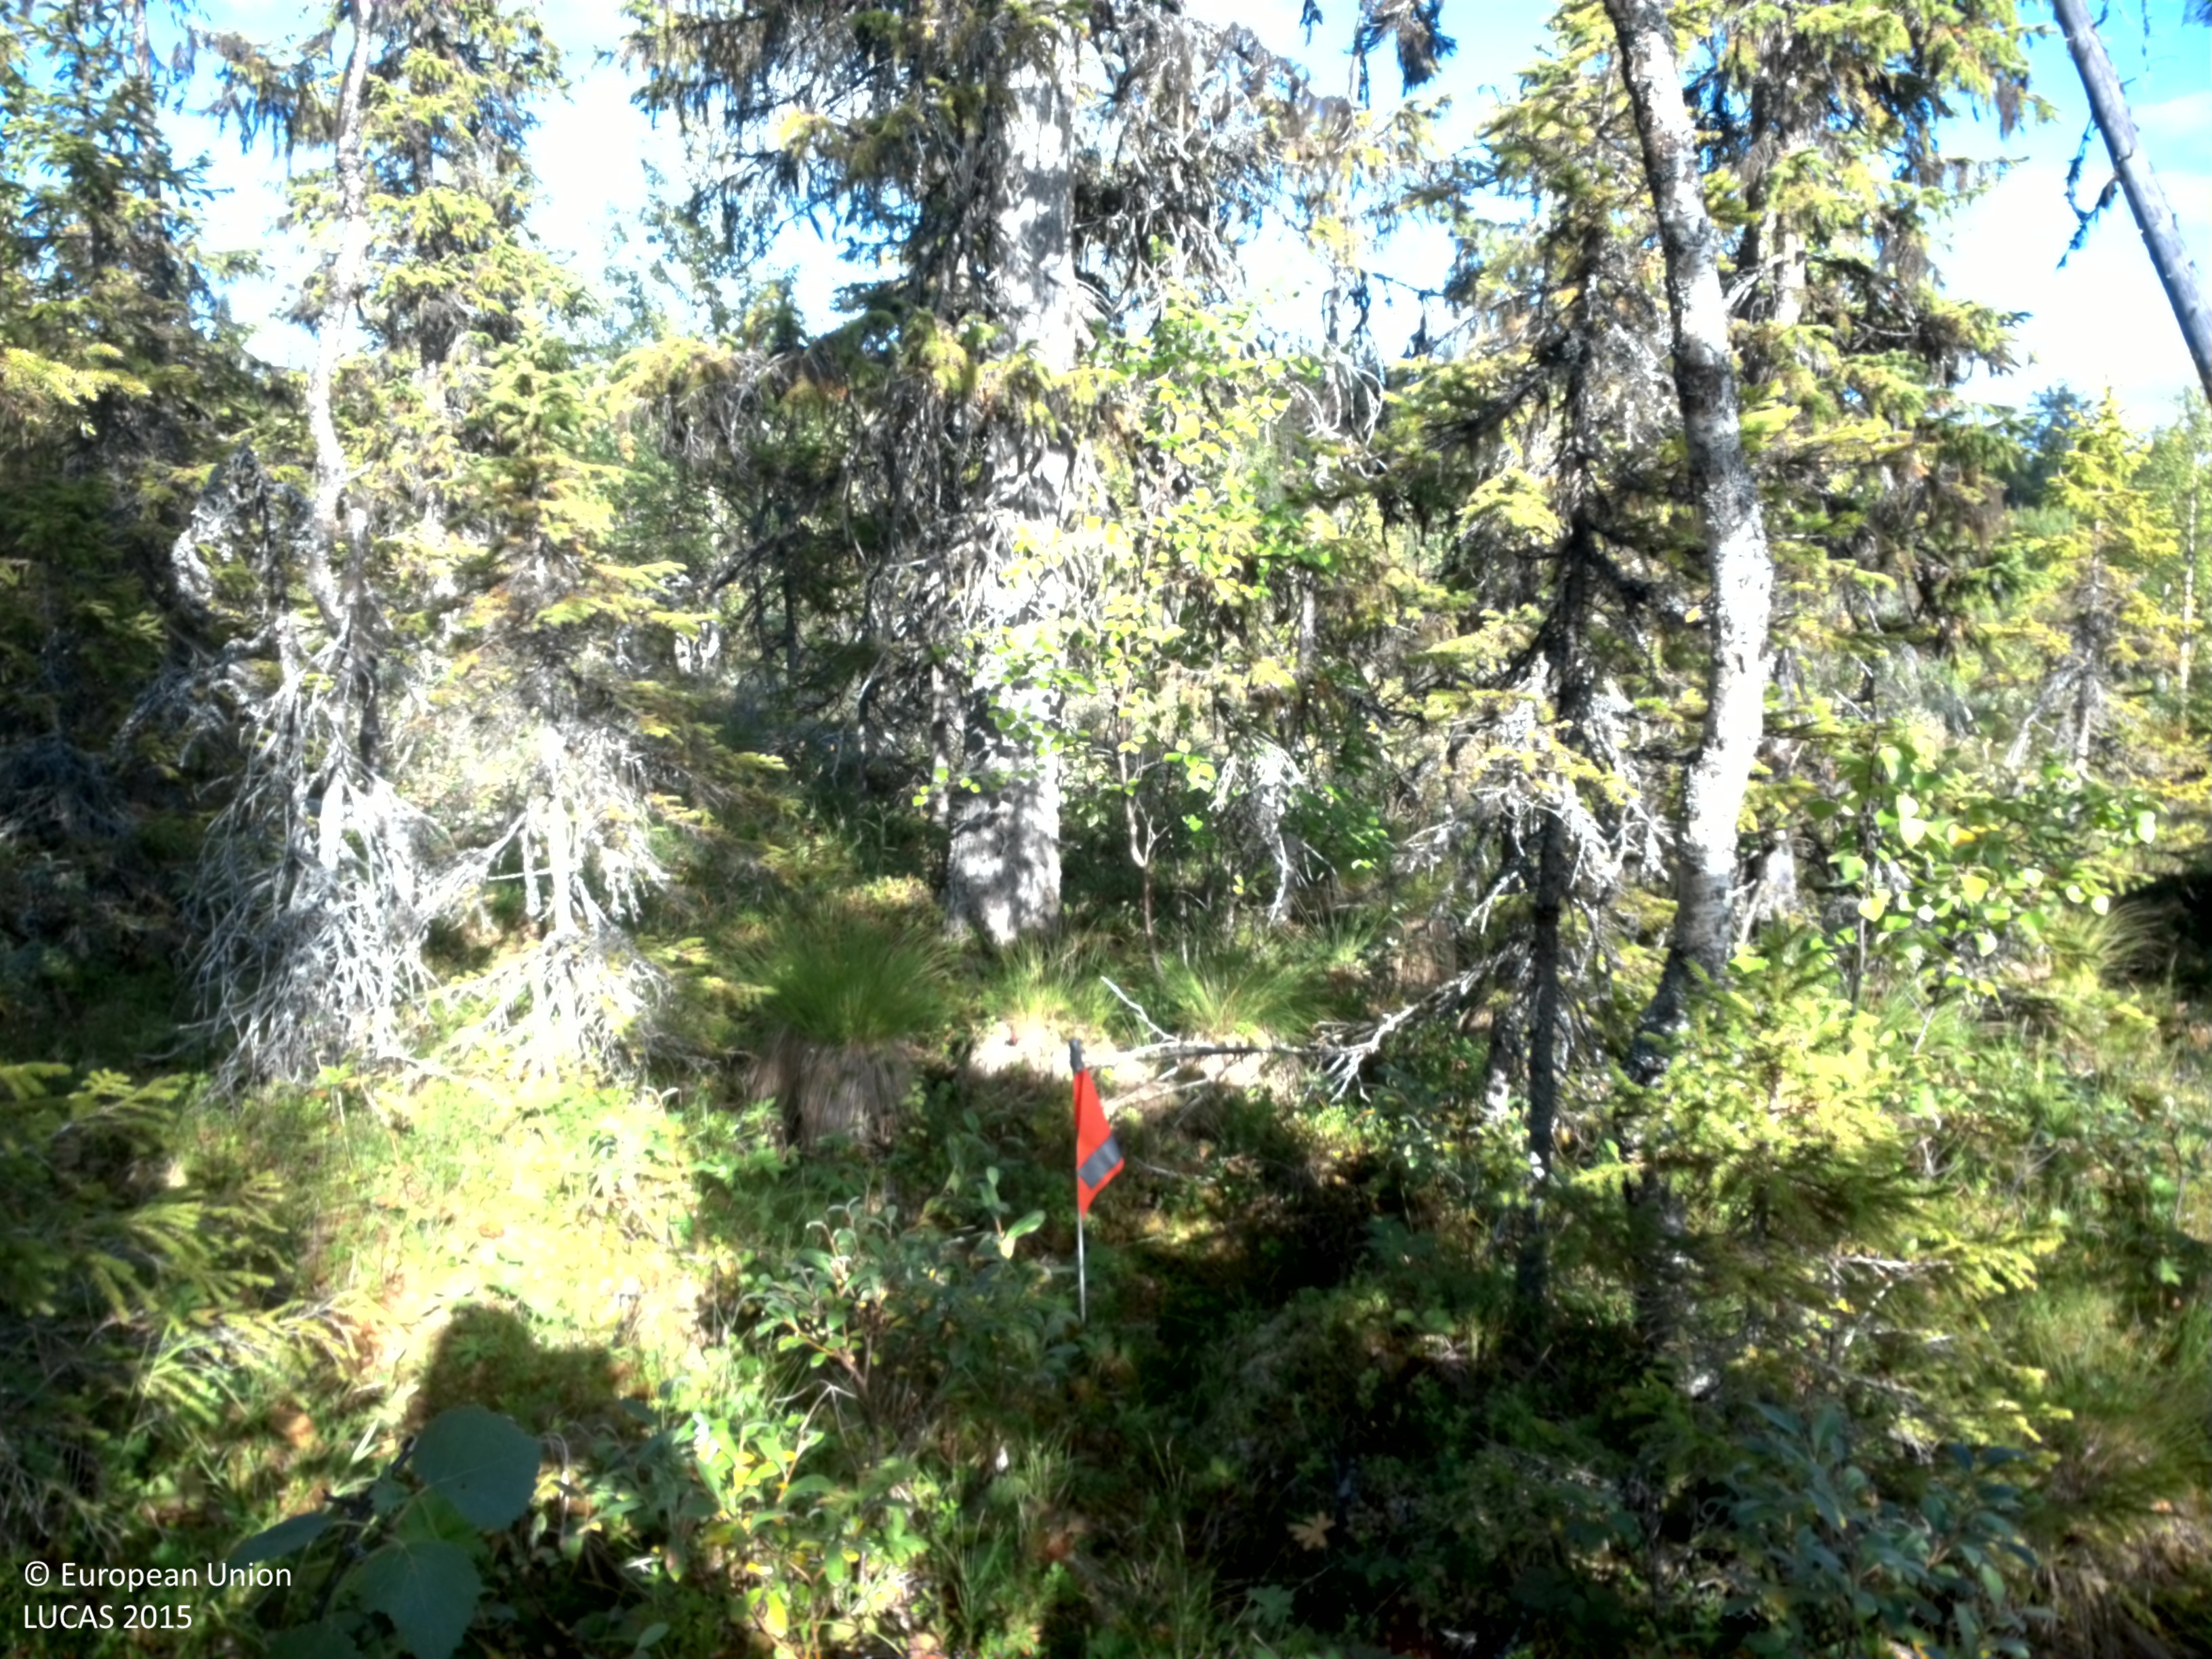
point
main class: Woodland
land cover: Spruce dominated mixed woodland
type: boreal forest
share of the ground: 25 - 50 %
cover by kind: shrubs 30 %, coniferous forest trees 25 %, herbaceous plants 20 %, lichens and mosses 15 %, broadleaved forest trees 10 %
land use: Forestry
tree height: > 5 m
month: September
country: SE
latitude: 65.1613
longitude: 16.3007
